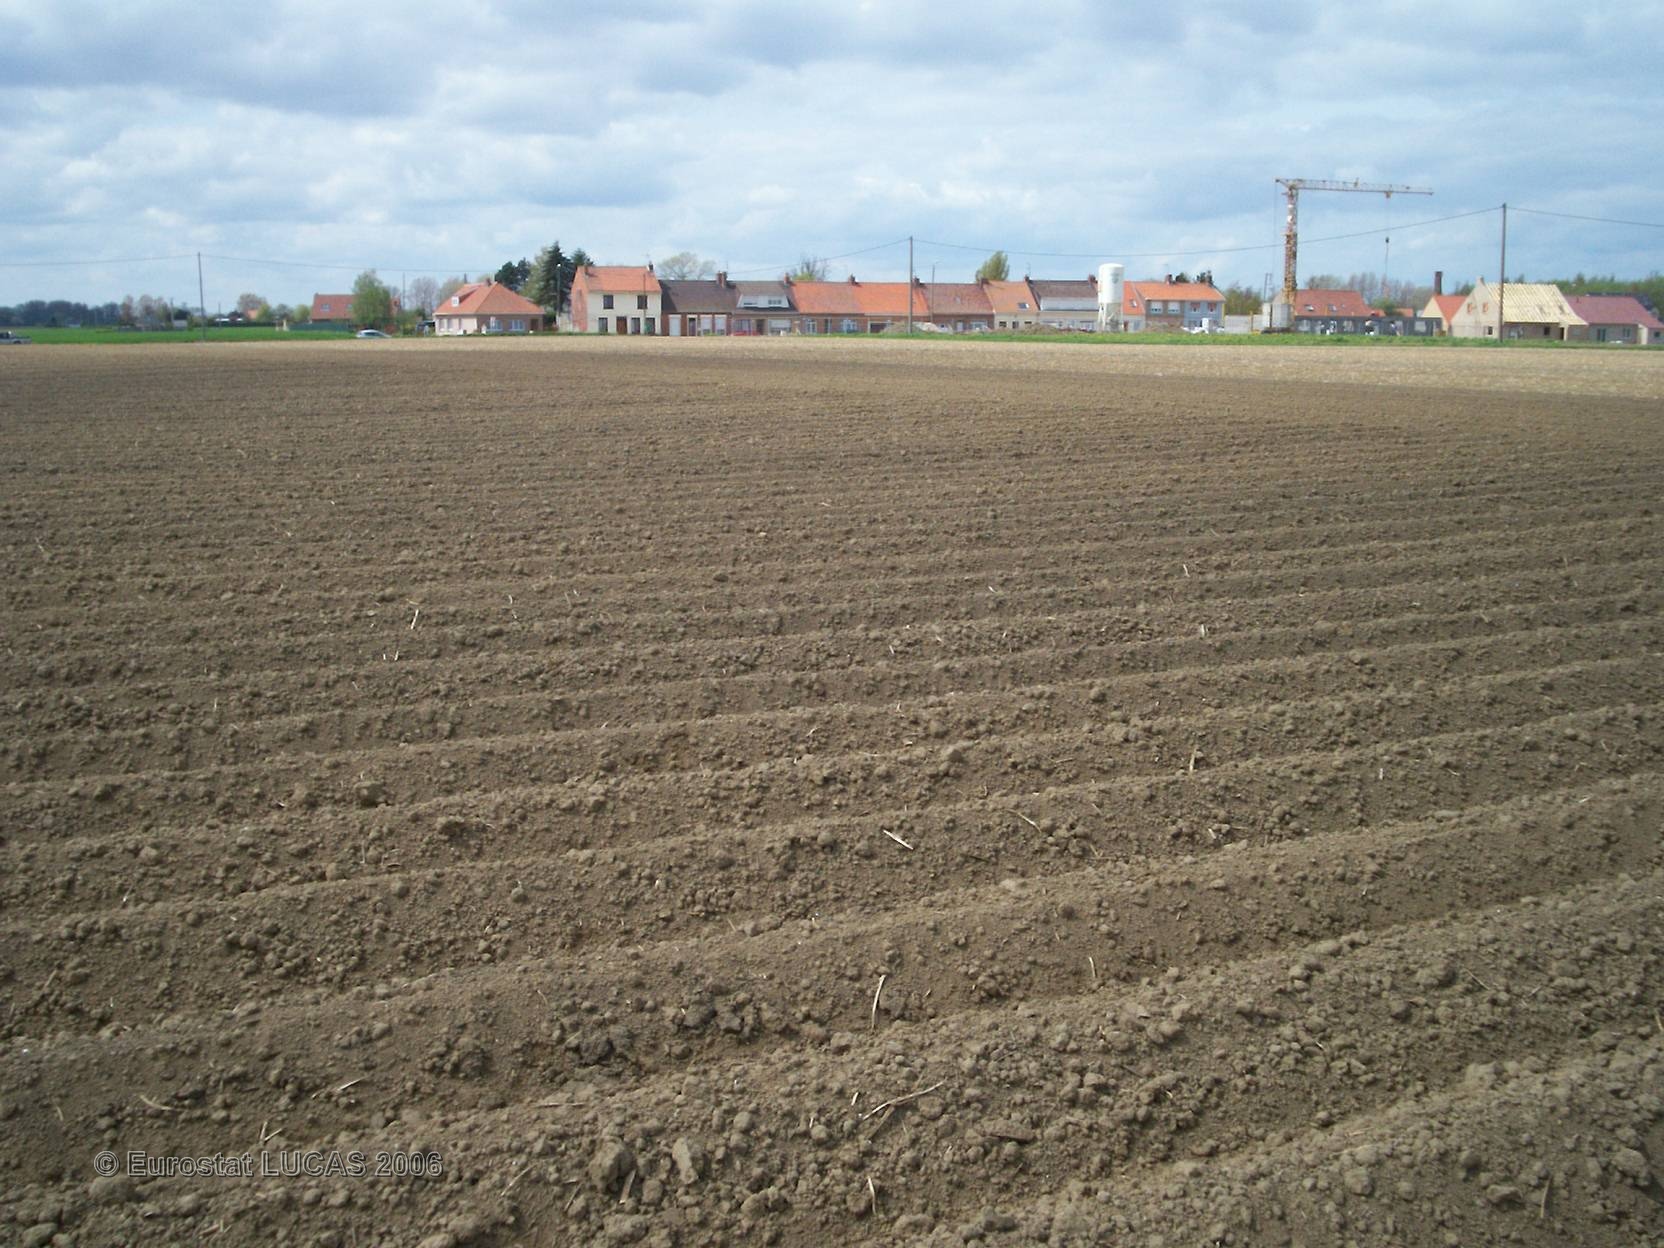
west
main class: Cropland
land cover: Potatoes
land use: Agriculture (excluding fallow land and kitchen gardens)
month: May
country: FR
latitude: 50.9333
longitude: 2.5456
